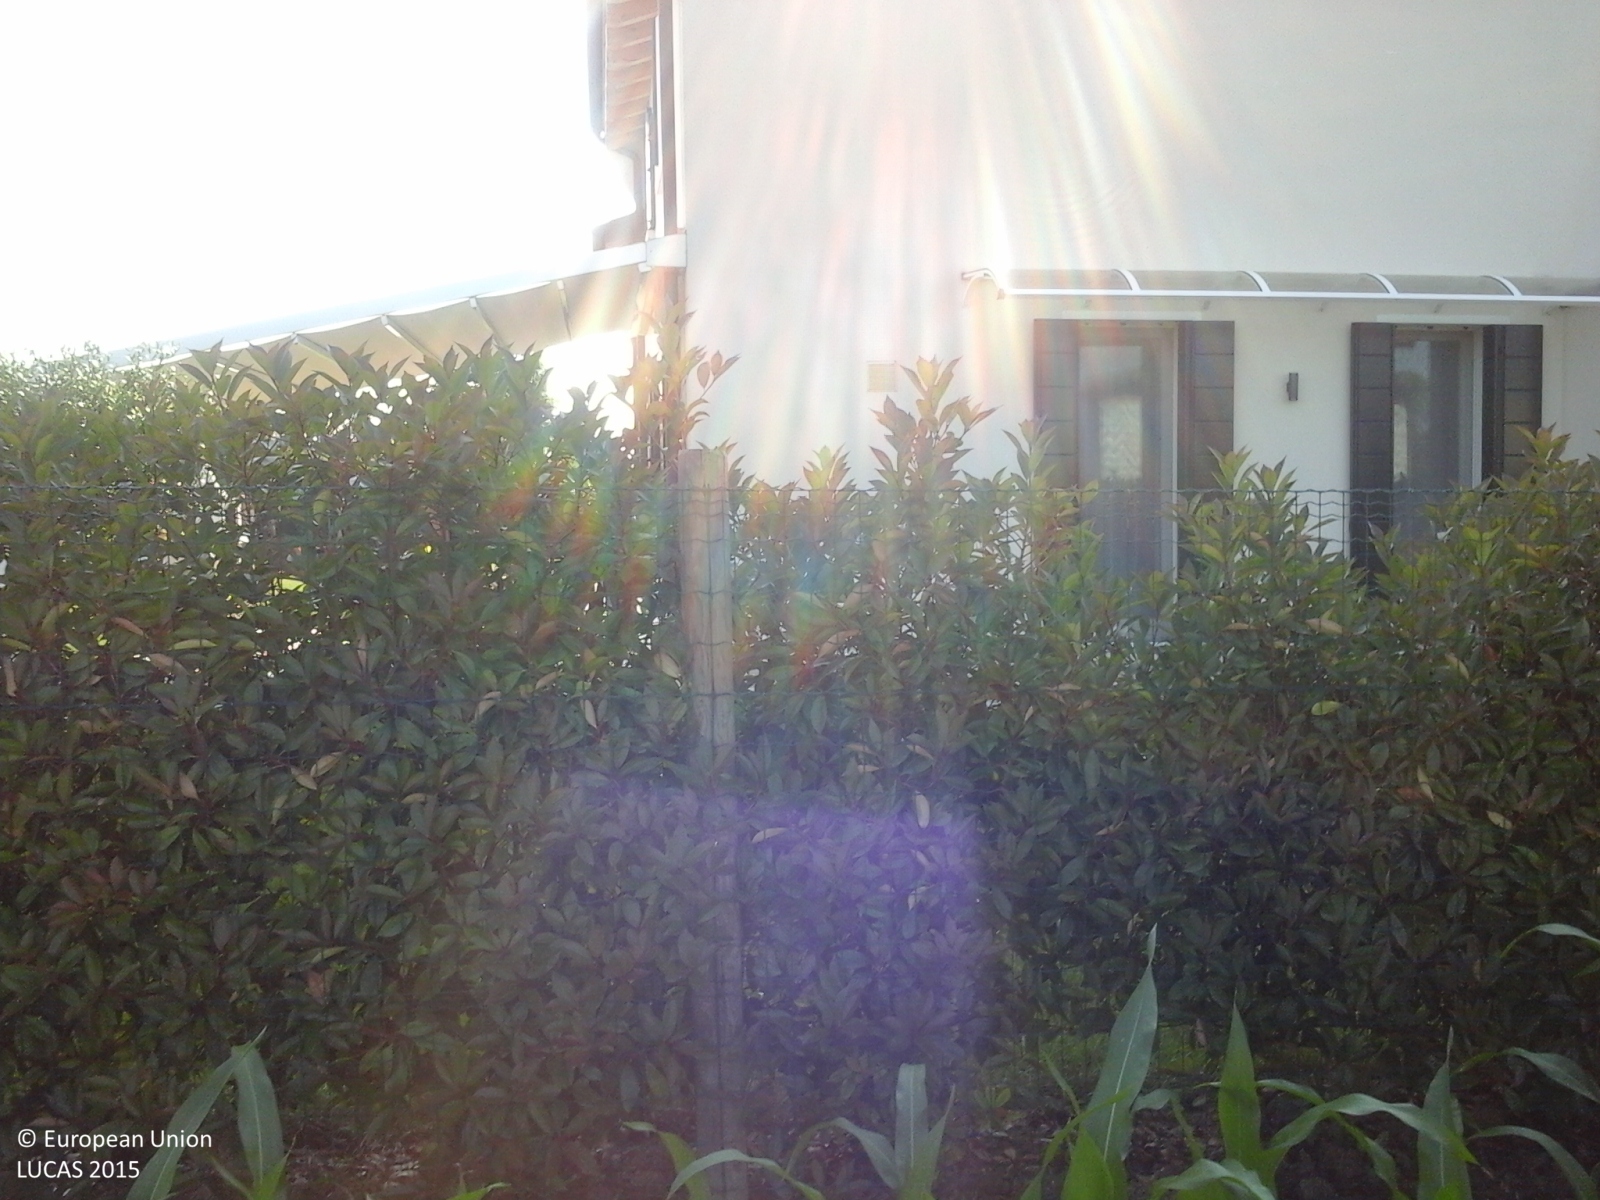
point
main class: Grassland
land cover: Grassland without tree/shrub cover
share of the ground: > 75 %
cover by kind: herbaceous plants 100 %
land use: Residential
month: June
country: IT
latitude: 45.6407
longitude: 12.3444
